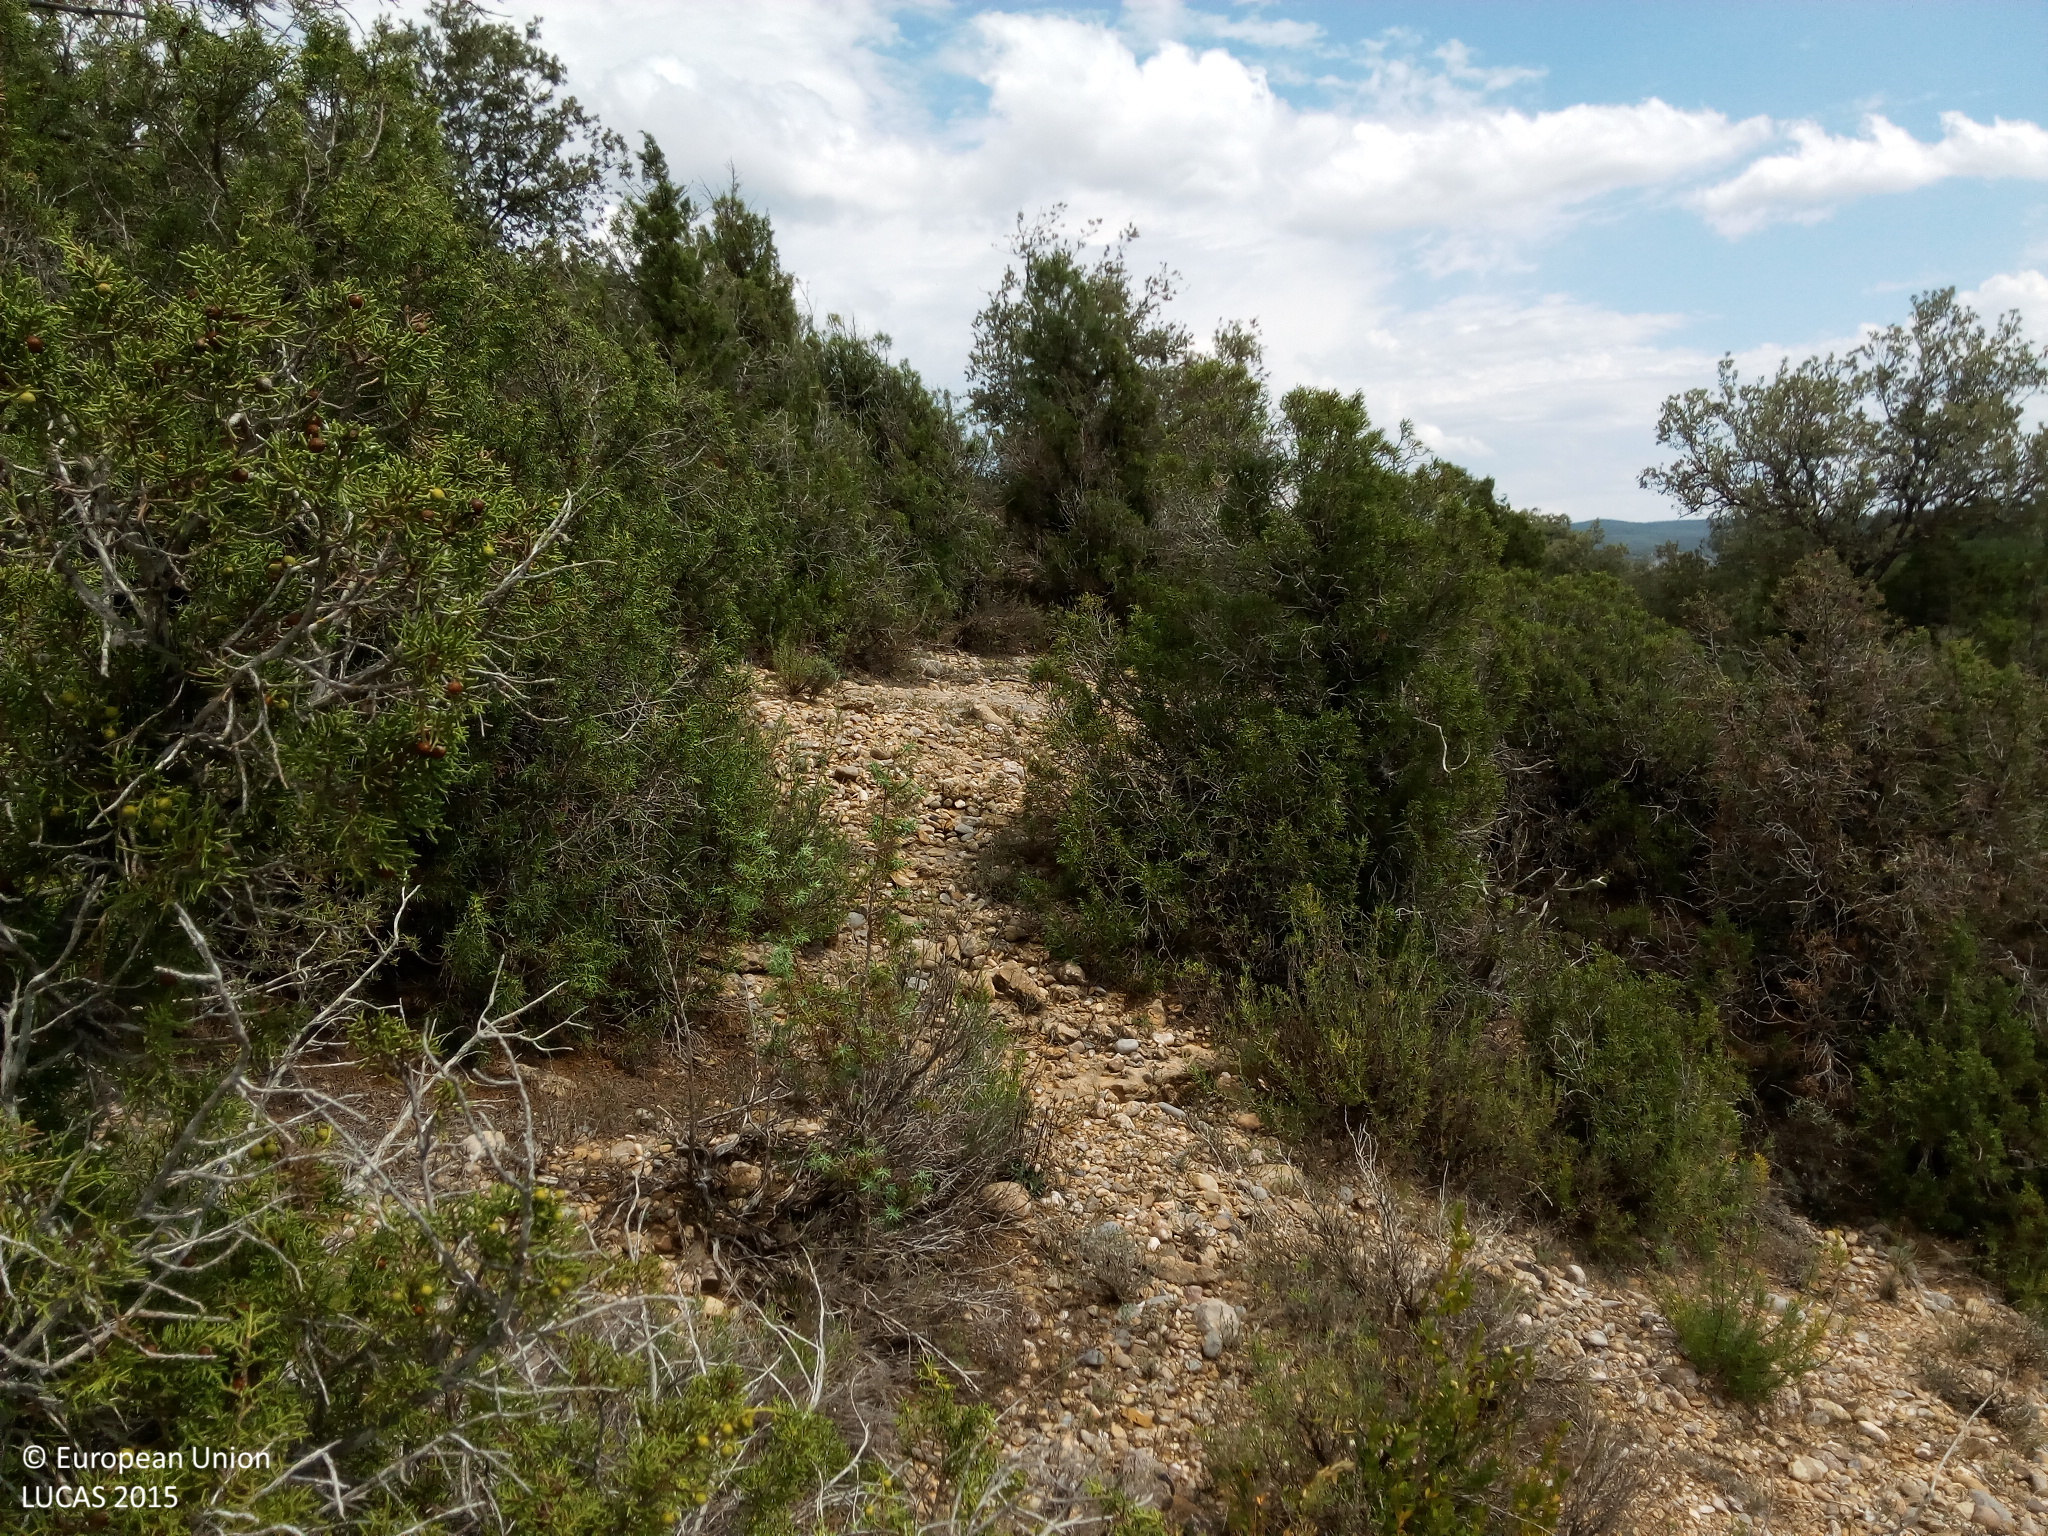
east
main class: Woodland
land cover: Broadleaved woodland
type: broadleaved evergreen forest
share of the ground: > 75 %
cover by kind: shrubs 30 %, herbaceous plants 30 %, broadleaved forest trees 20 %, consolidated bare surface 20 %
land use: Semi-natural and natural areas not in use
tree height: < 5 m
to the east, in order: Broadleaved woodland
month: August
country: ES
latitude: 42.1192
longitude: 0.5369
